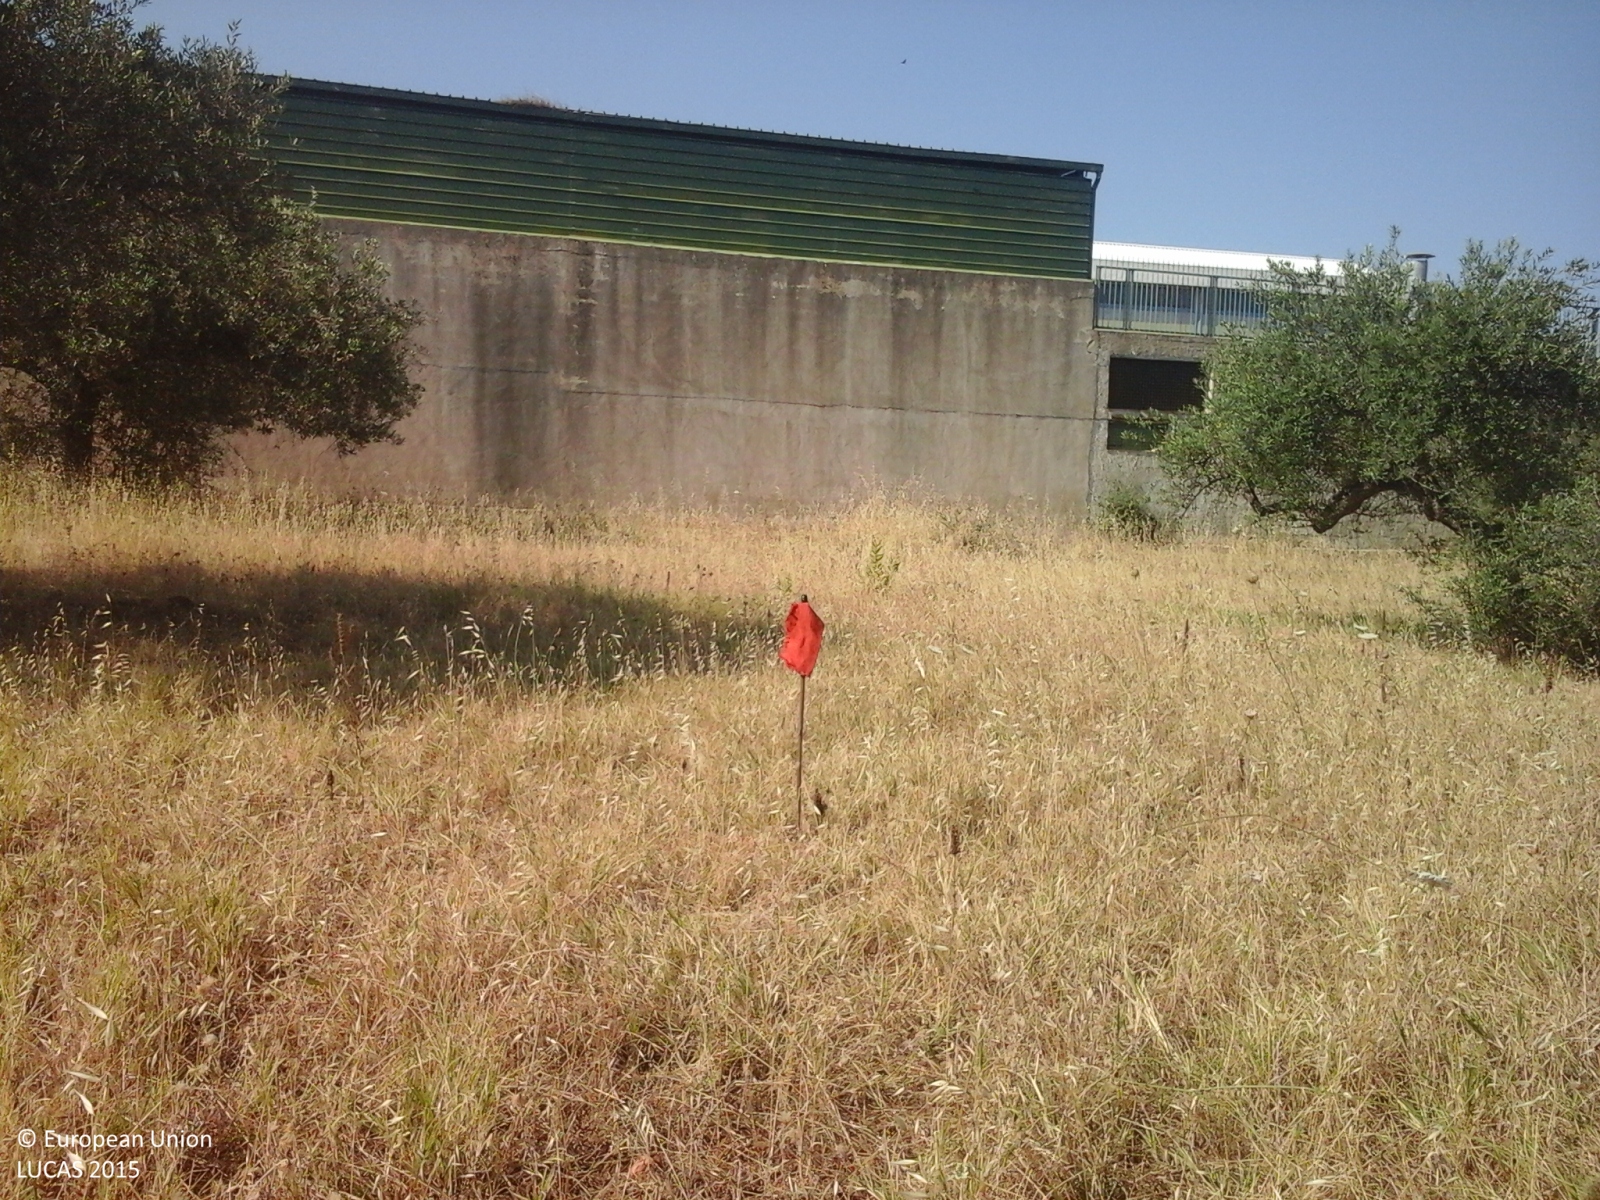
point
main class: Cropland
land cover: Olive groves
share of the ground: 25 - 50 %
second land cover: Spontaneously vegetated surfaces
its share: > 75 %
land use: Agriculture (excluding fallow land and kitchen gardens)
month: May
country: IT
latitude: 37.6282
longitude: 12.9801
